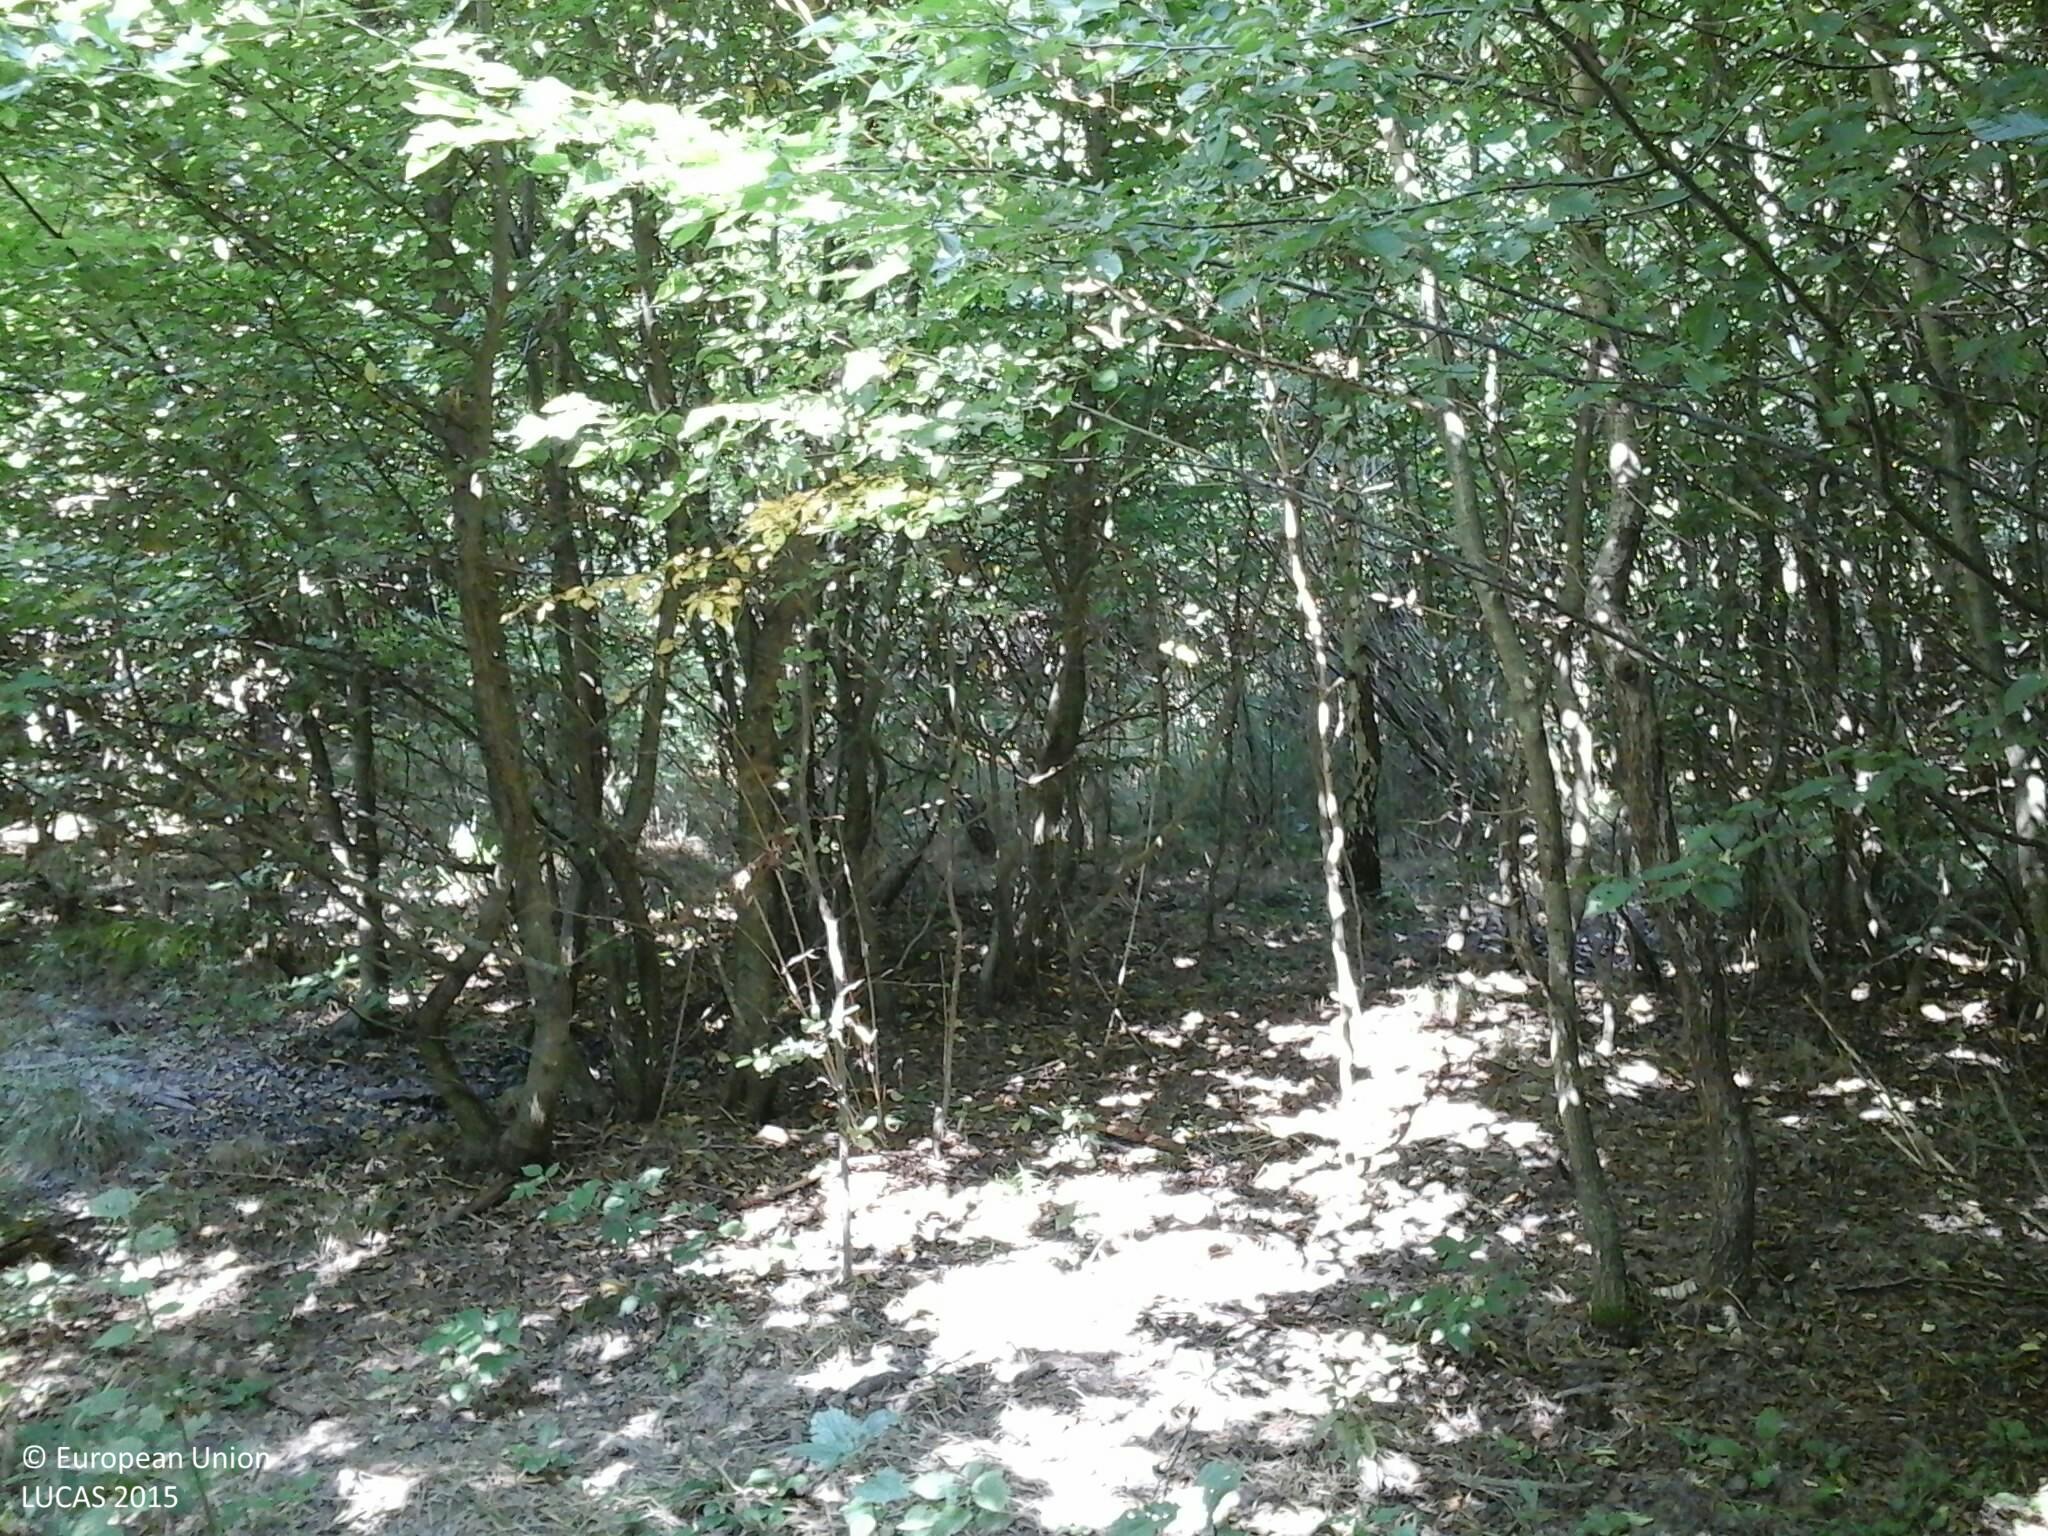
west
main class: Woodland
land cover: Broadleaved woodland
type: beech forest
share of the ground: > 75 %
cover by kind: broadleaved forest trees 80 %, shrubs 10 %, herbaceous plants 10 %
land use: Forestry
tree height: > 5 m
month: July
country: HU
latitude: 46.9854
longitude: 16.4842
